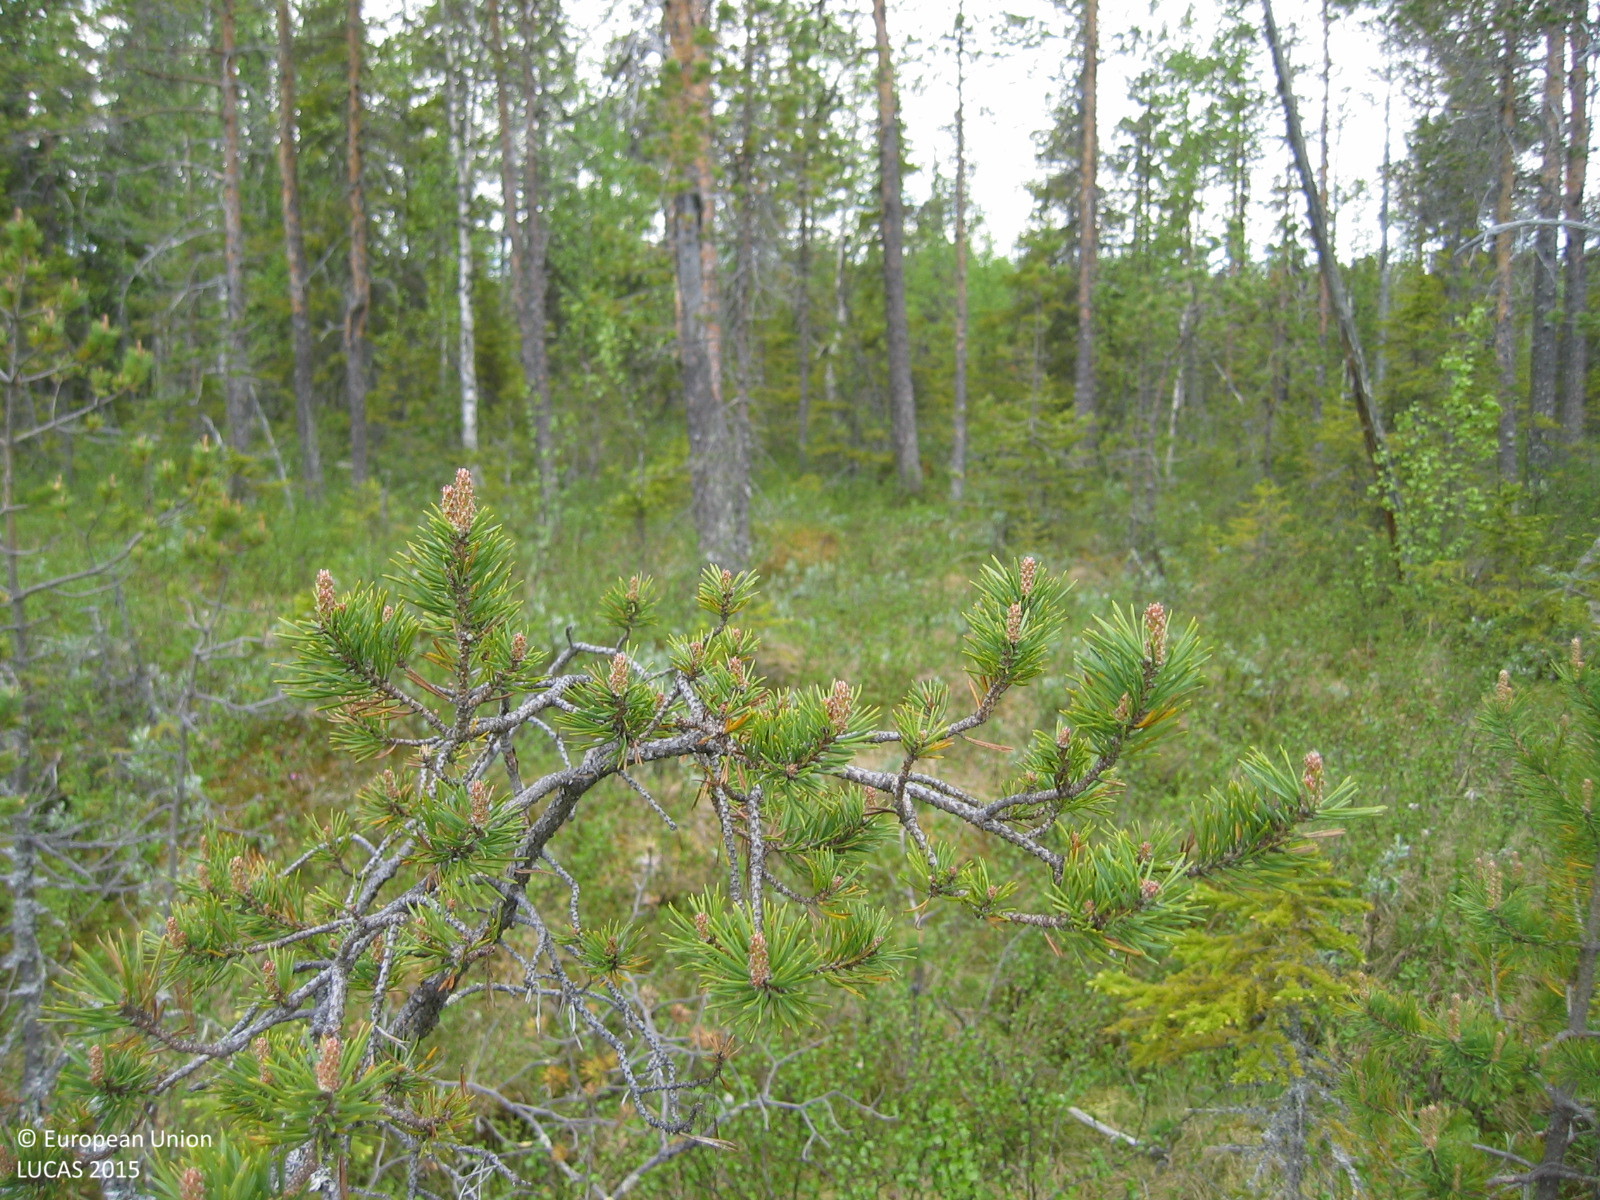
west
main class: Woodland
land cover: Pine dominated coniferous woodland
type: boreal forest
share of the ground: 50 - 75 %
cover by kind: coniferous forest trees 60 %, shrubs 40 %
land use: Semi-natural and natural areas not in use
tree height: > 5 m
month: June
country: SE
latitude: 63.5327
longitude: 14.7031
